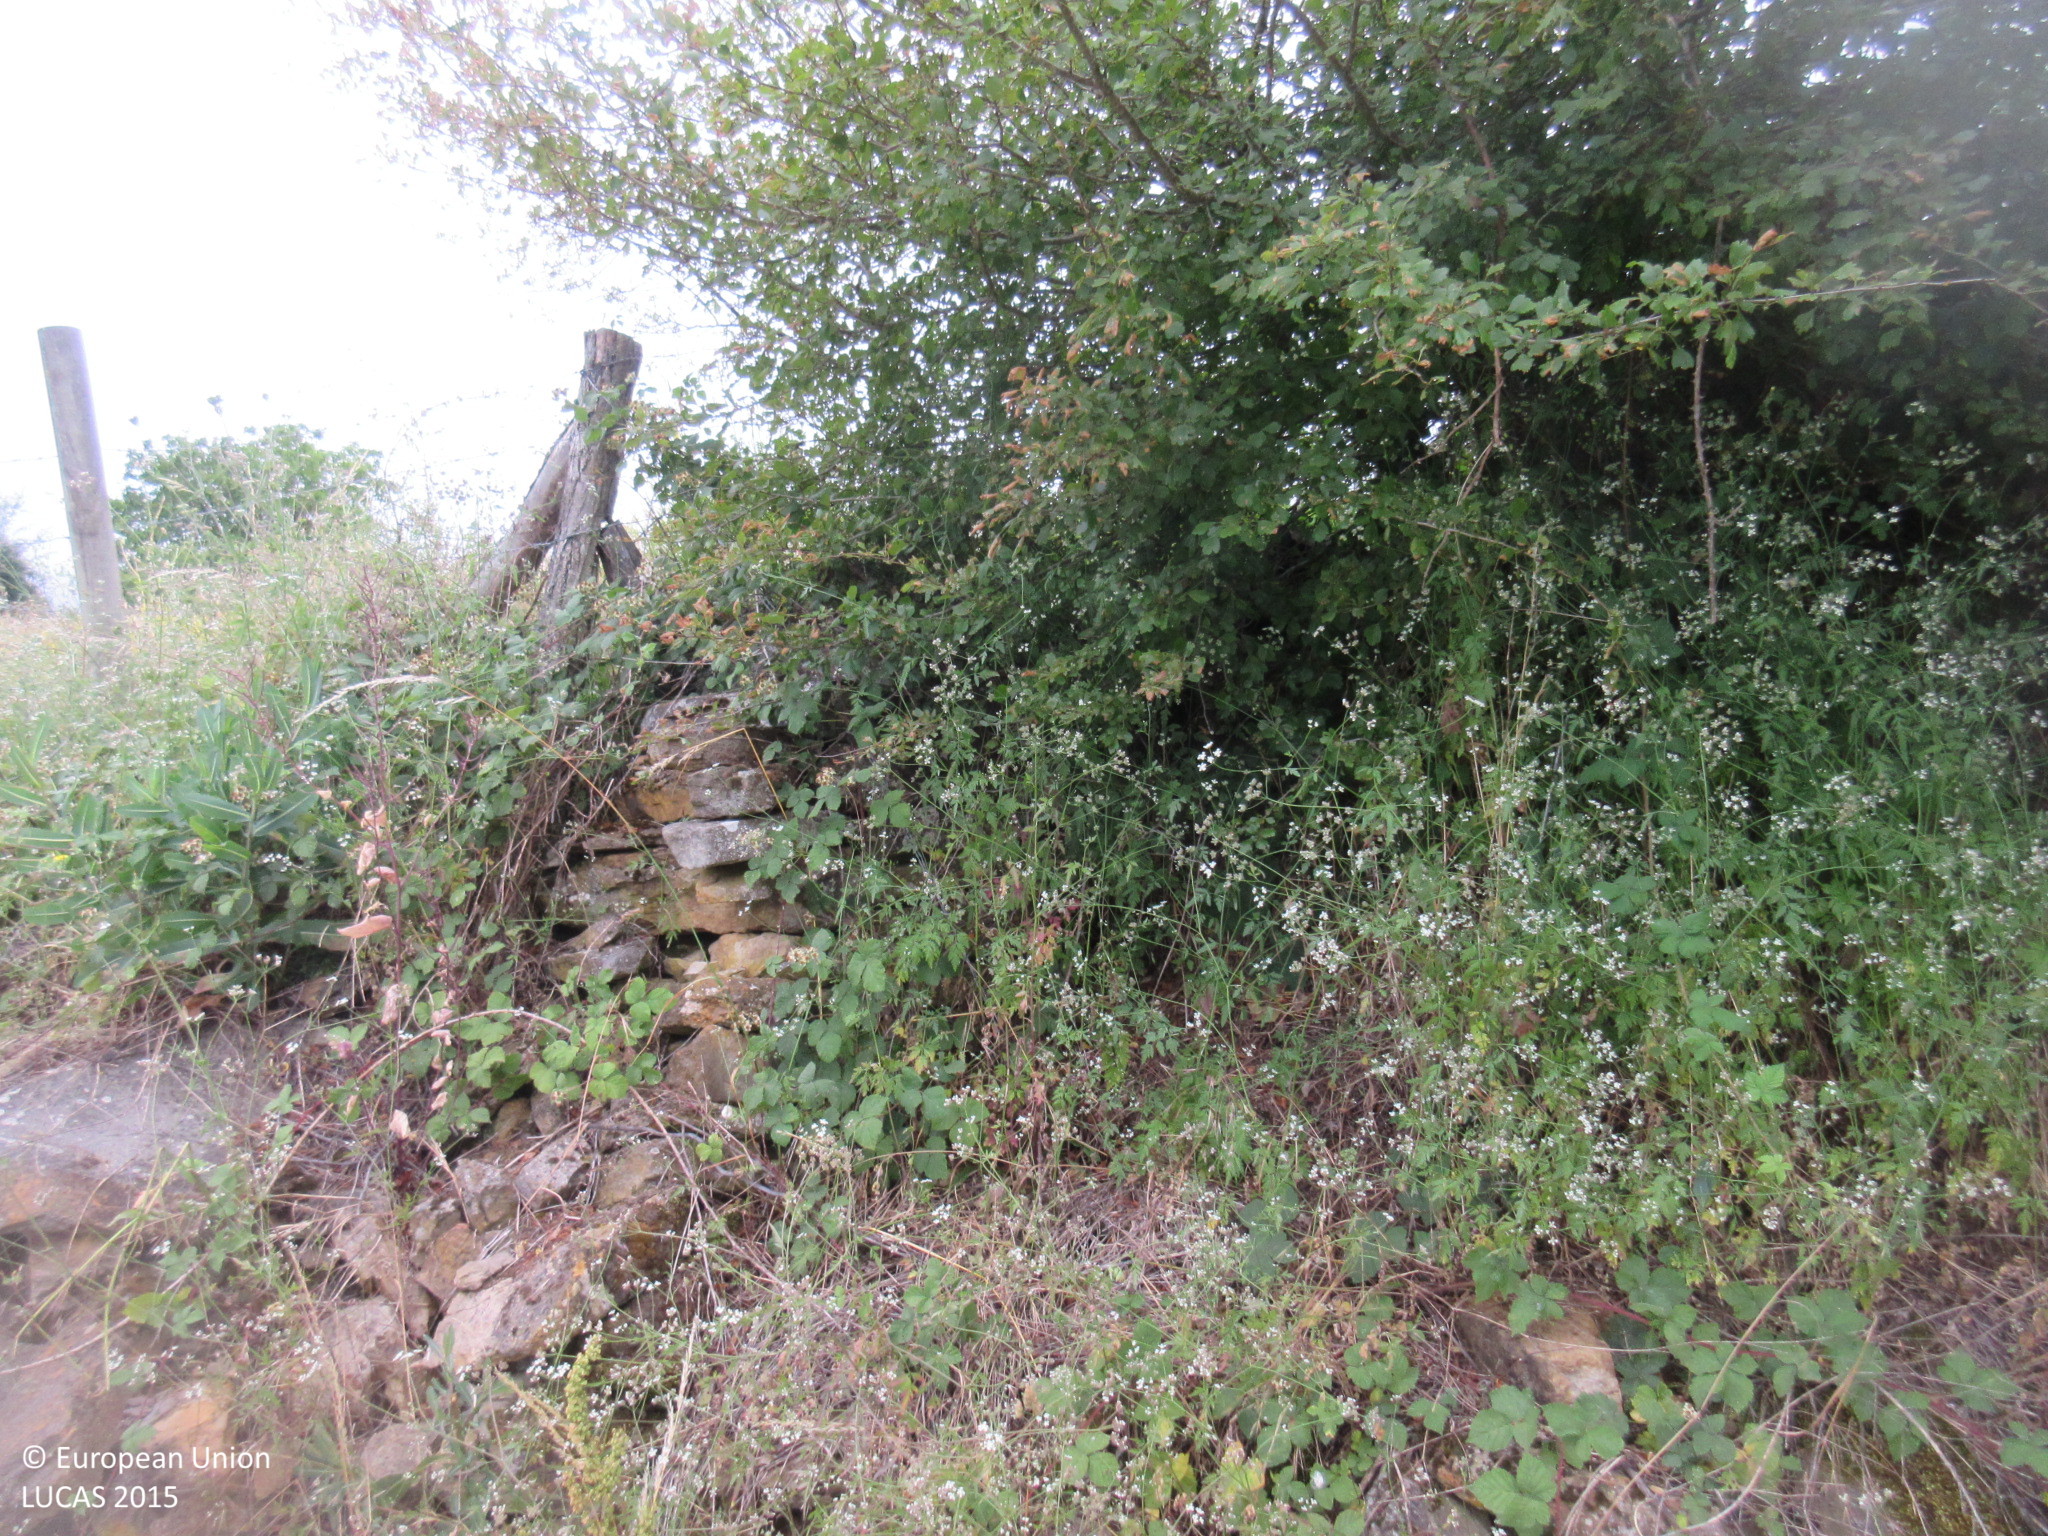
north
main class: Shrubland
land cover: Shrubland with sparse tree cover
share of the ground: > 75 %
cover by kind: shrubs 95 %, broadleaved forest trees 5 %
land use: Semi-natural and natural areas not in use
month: July
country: ES
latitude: 43.0749
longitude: -3.5387
